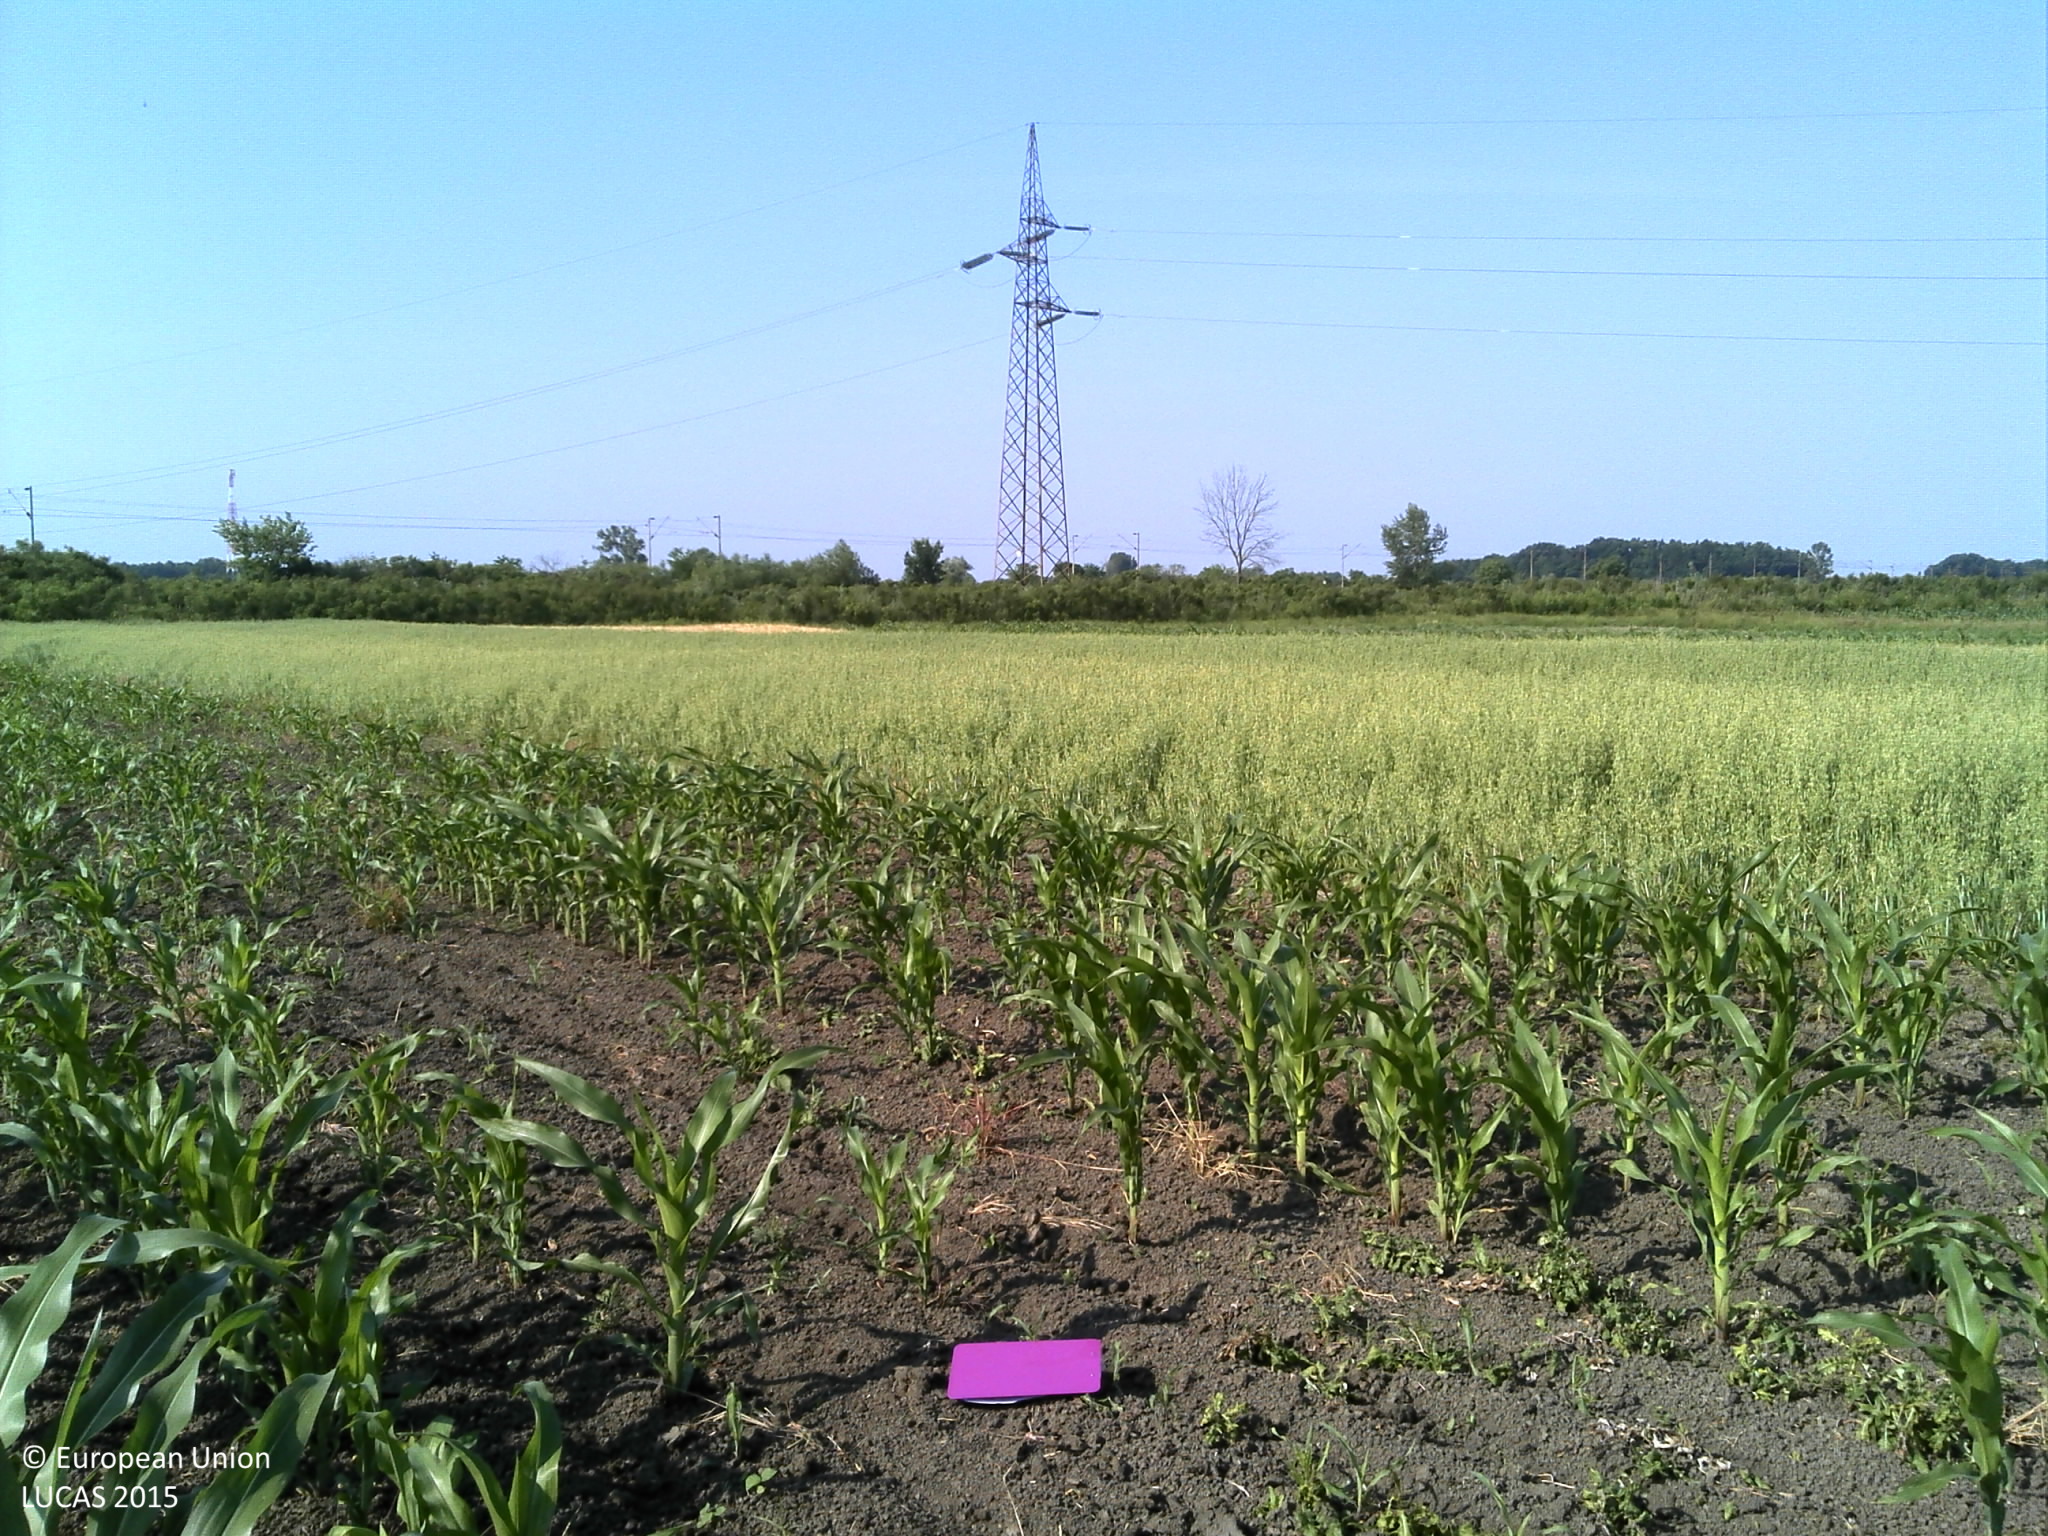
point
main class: Cropland
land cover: Maize
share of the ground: 25 - 50 %
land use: Agriculture (excluding fallow land and kitchen gardens)
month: June
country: HR
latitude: 45.2376
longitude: 18.4507
